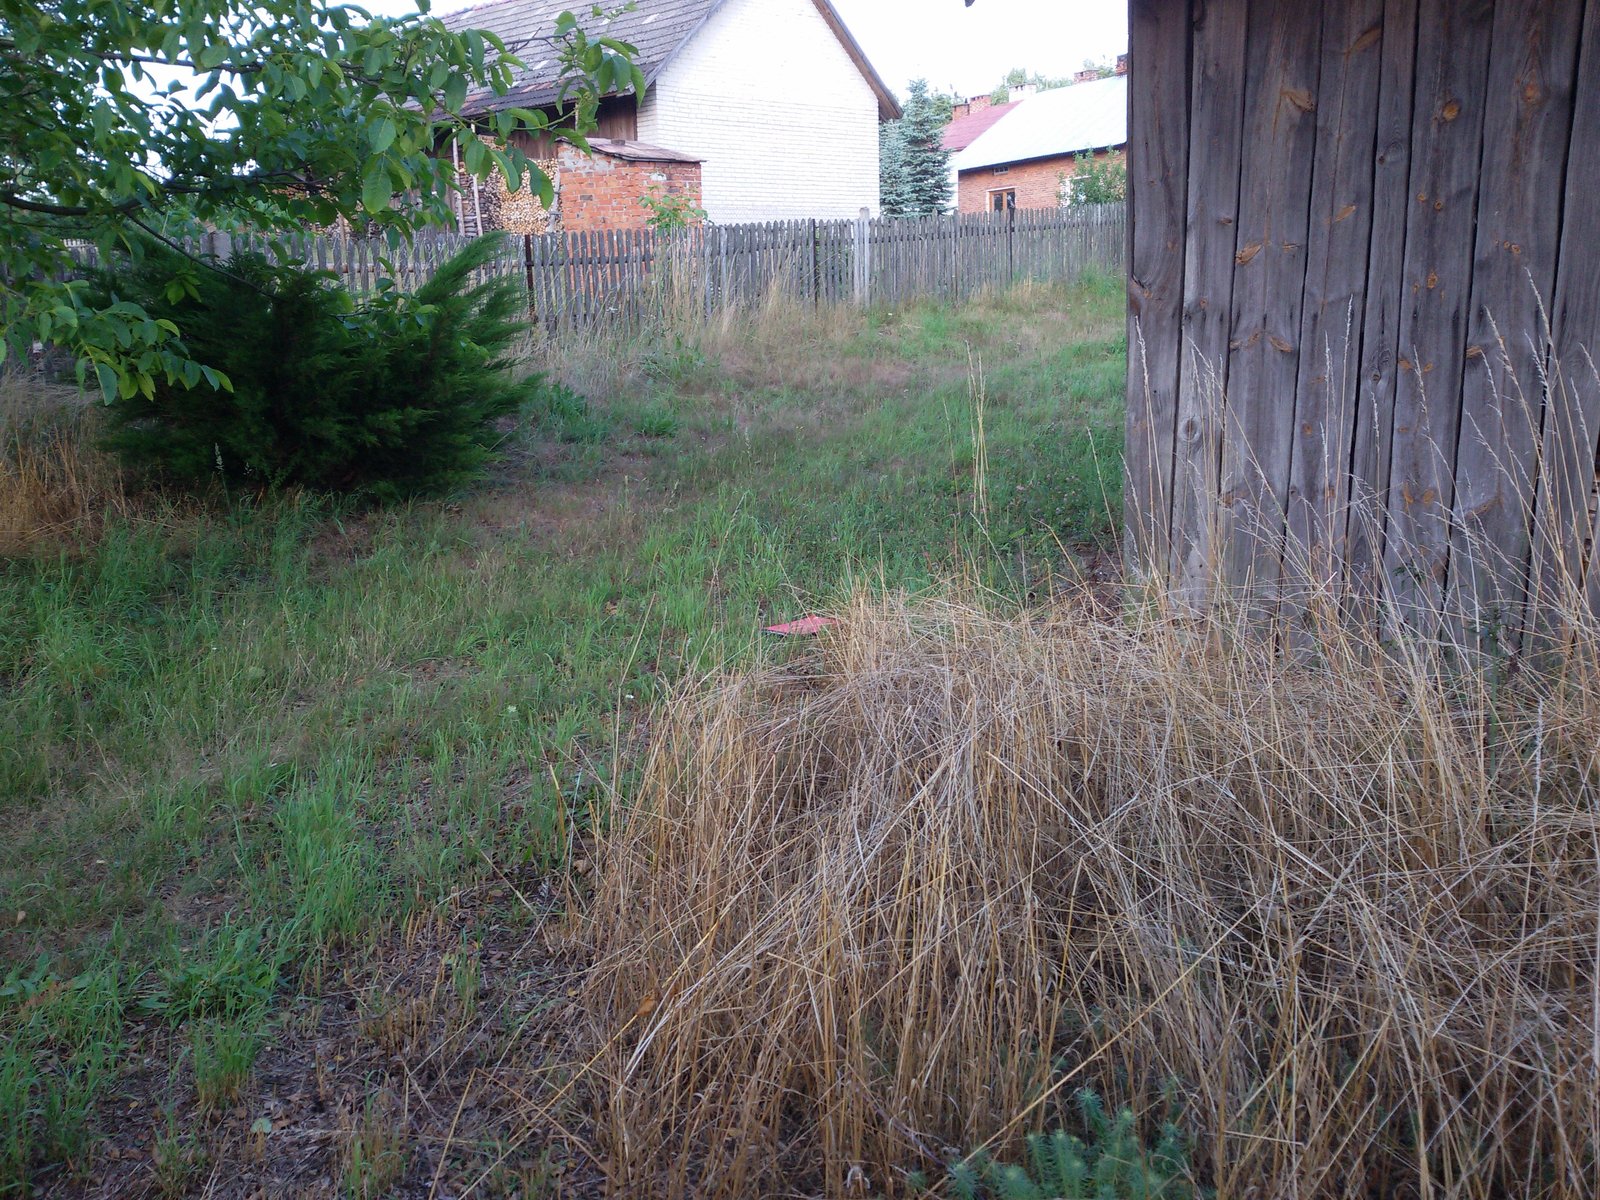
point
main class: Grassland
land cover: Grassland with sparse tree/shrub cover
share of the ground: 50 - 75 %
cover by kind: herbaceous plants 95 %, coniferous forest trees 5 %
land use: Residential
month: July
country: PL
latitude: 50.2158
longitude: 22.3820
